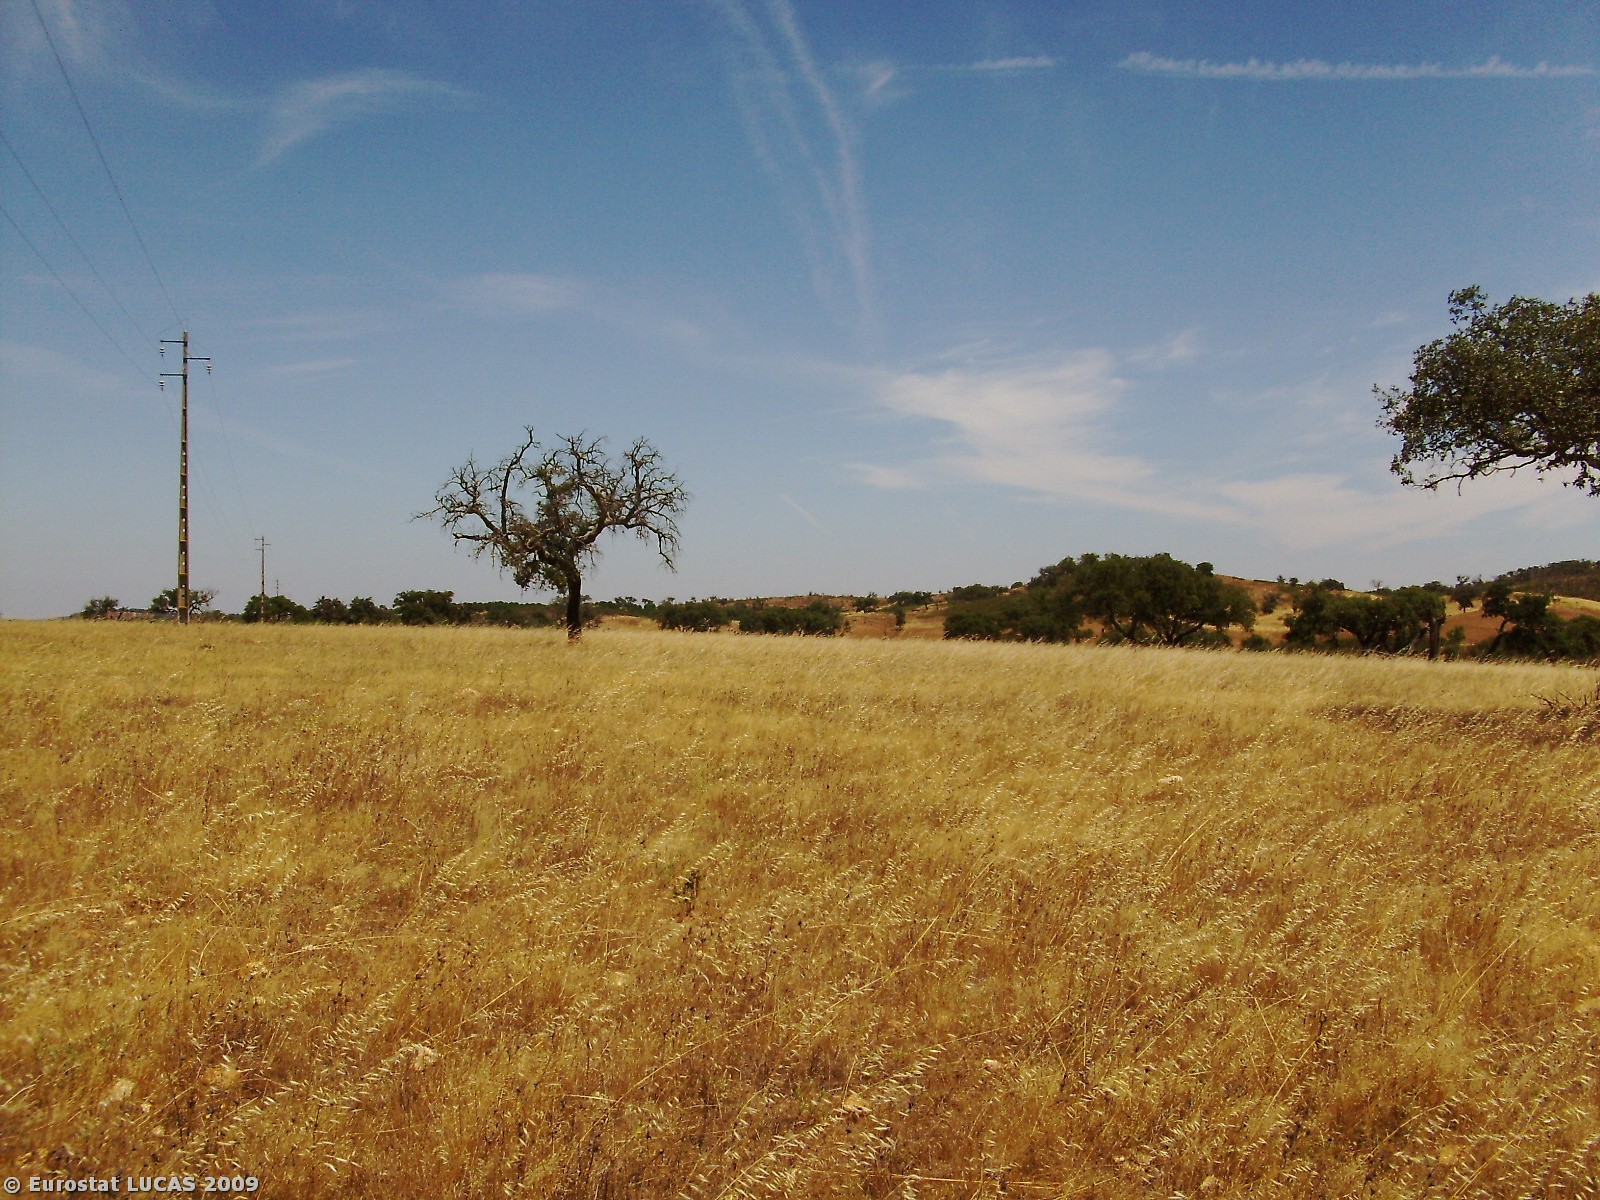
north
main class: Grassland
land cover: Grassland with sparse tree/shrub cover
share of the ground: > 75 %
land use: Agriculture (excluding fallow land and kitchen gardens)
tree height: > 5 m
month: July
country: PT
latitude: 37.7535
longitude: -8.3880
